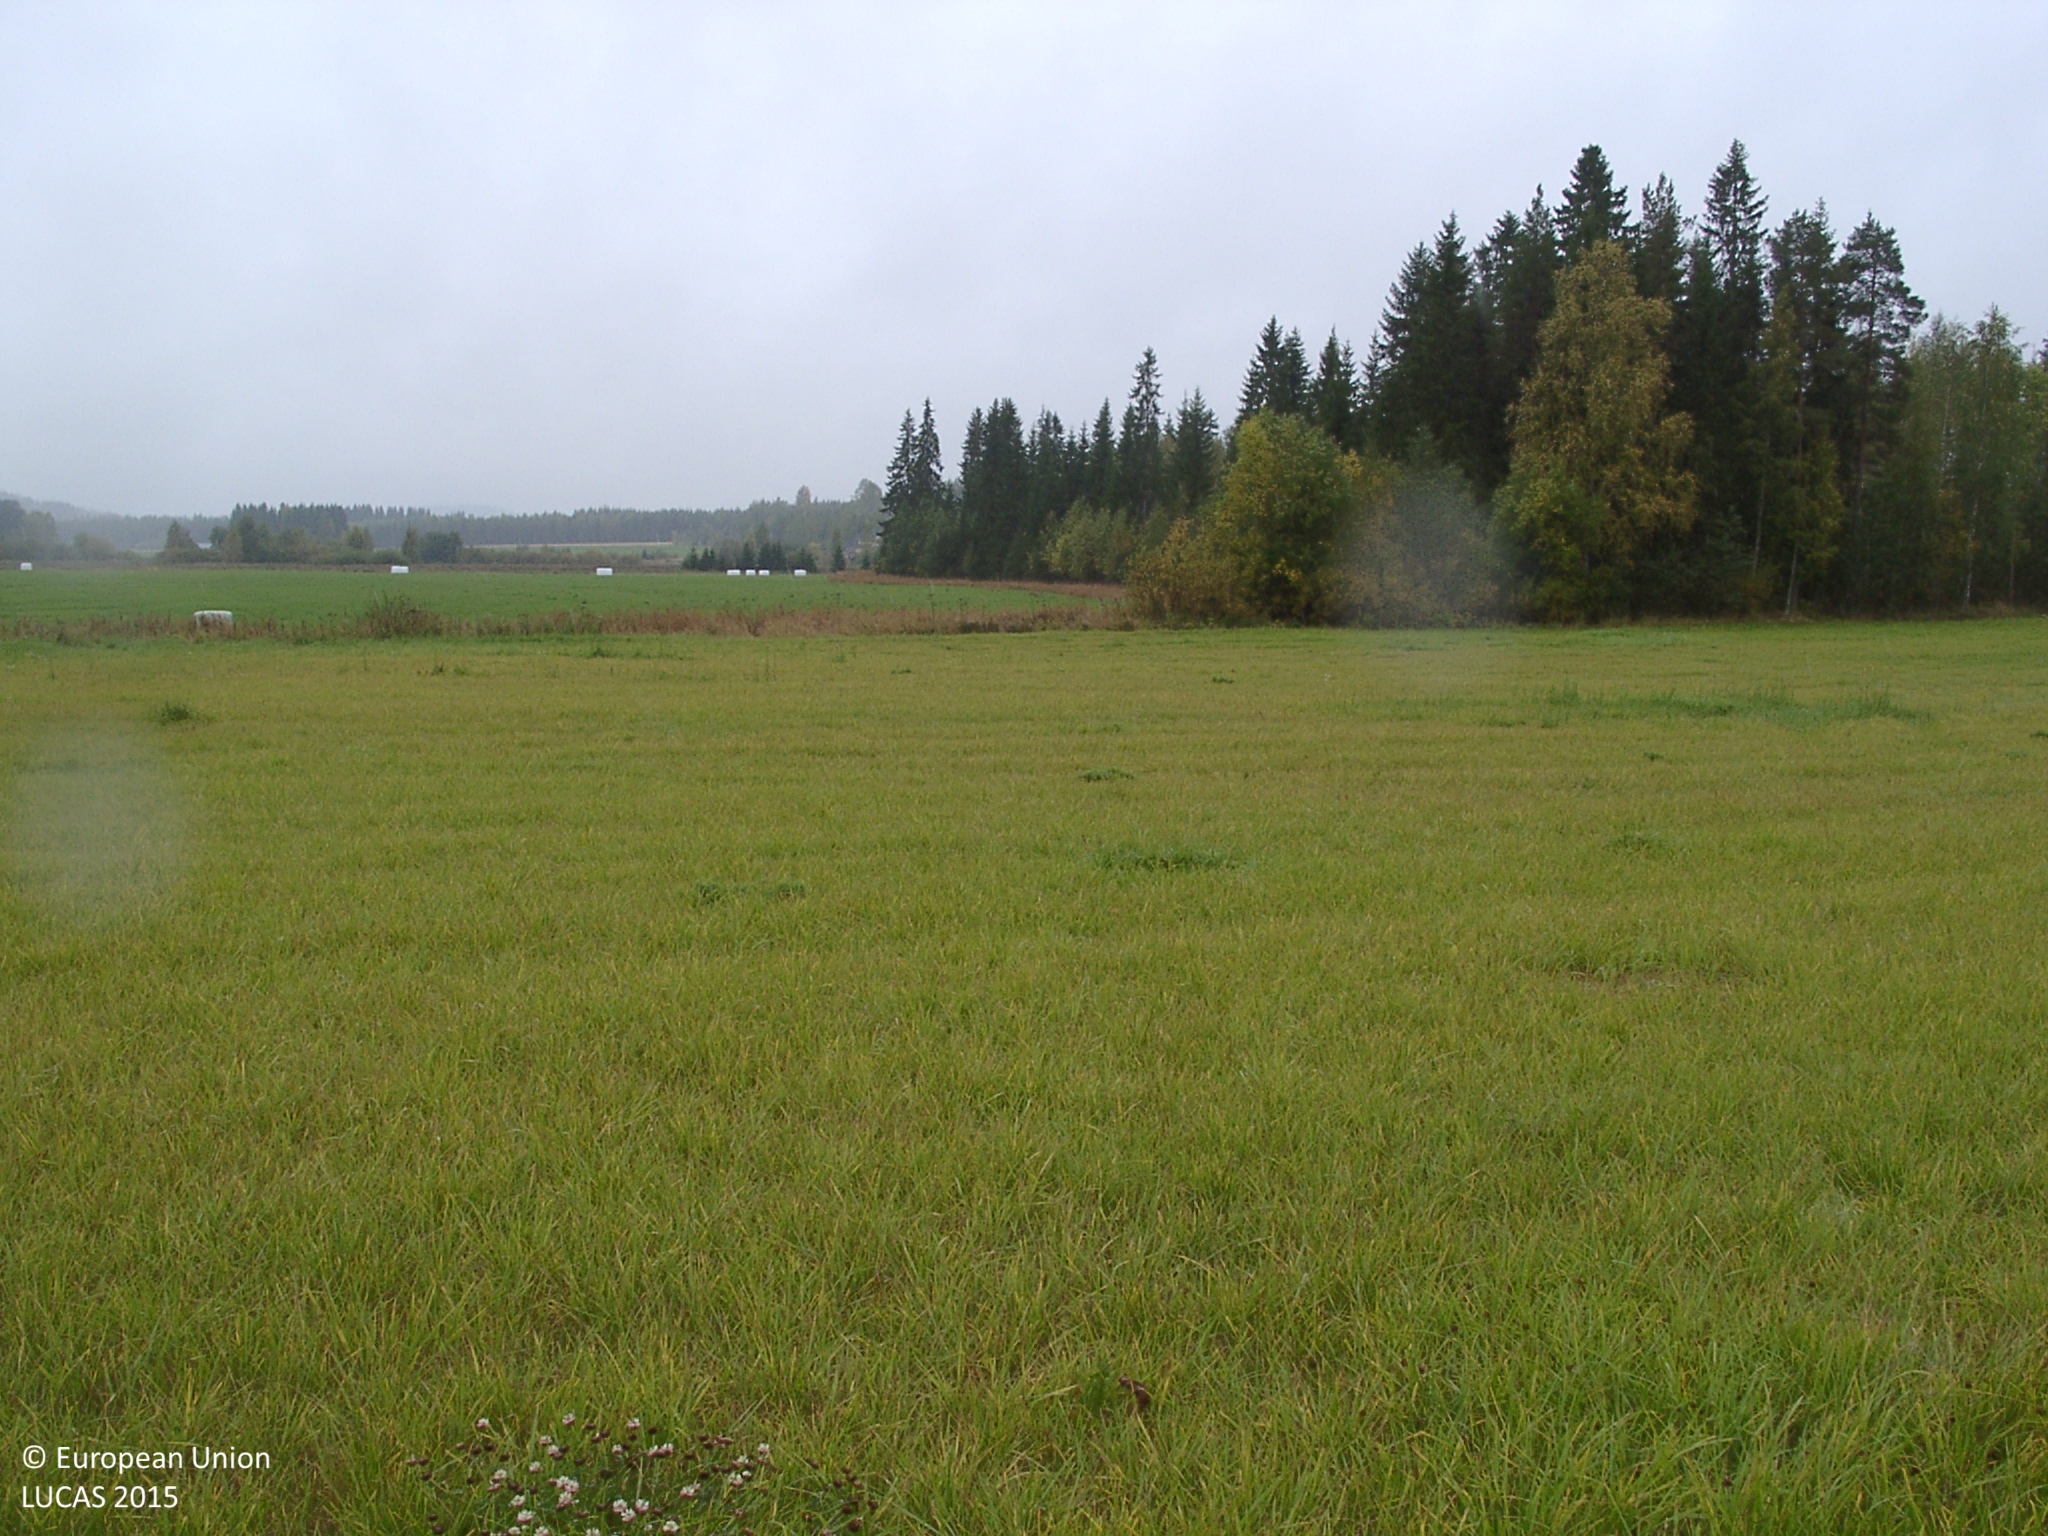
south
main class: Cropland
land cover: Temporary grasslands
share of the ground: > 75 %
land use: Agriculture (excluding fallow land and kitchen gardens)
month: September
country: FI
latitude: 62.5646
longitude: 25.6194
